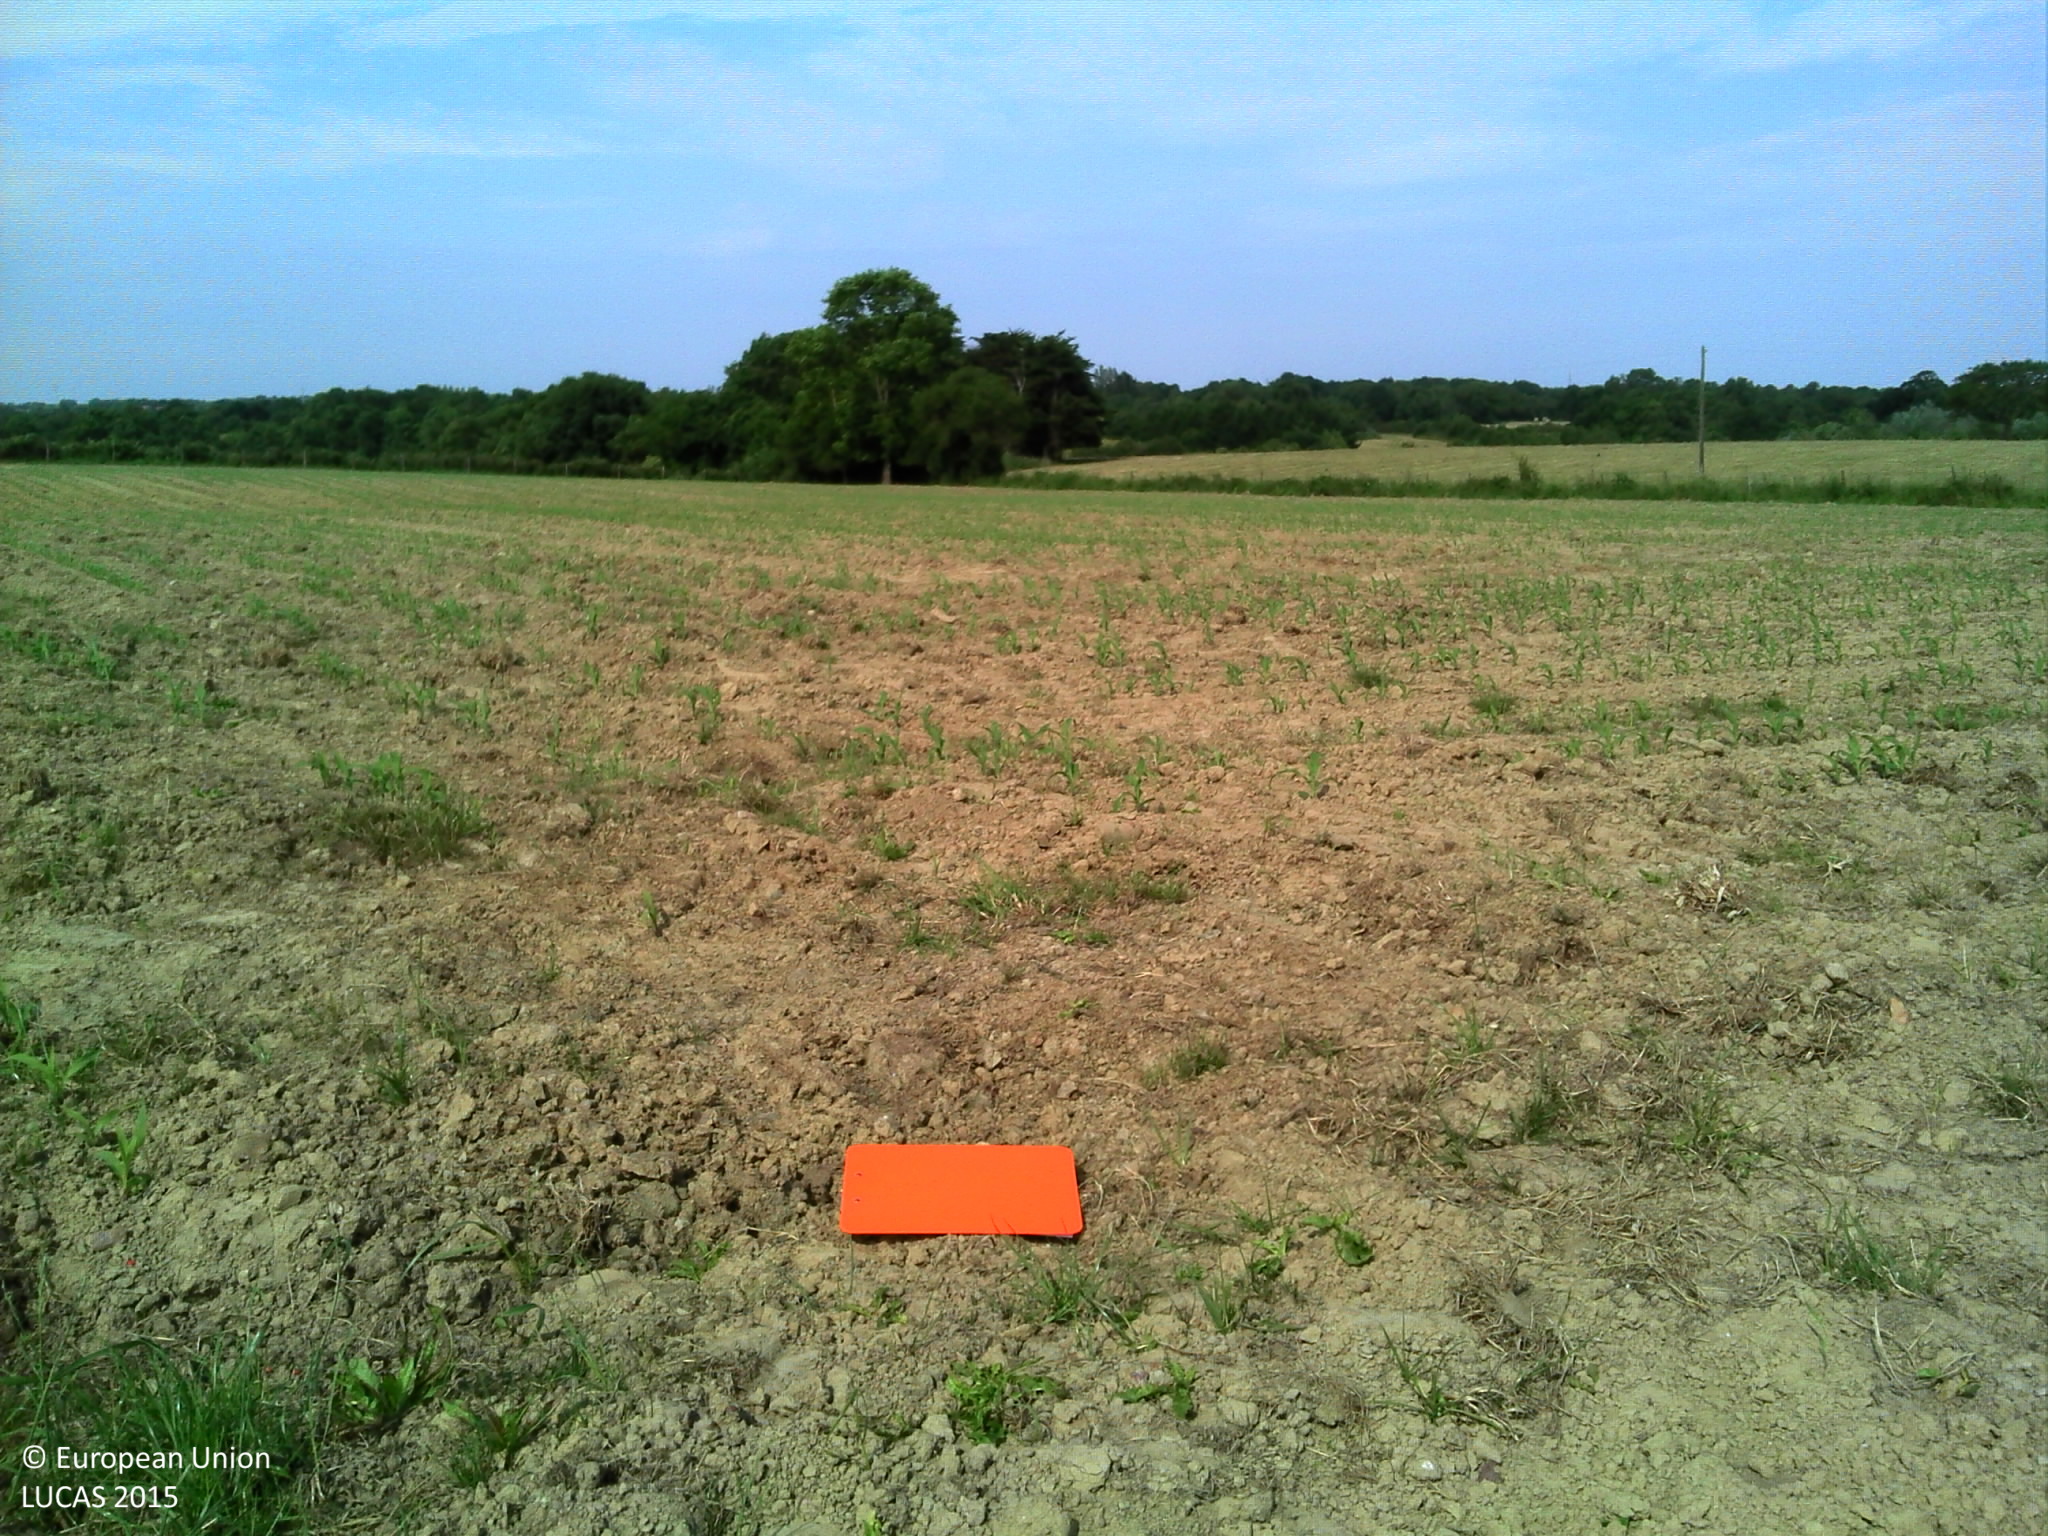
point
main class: Cropland
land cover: Maize
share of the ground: 10 - 25 %
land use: Agriculture (excluding fallow land and kitchen gardens)
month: June
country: FR
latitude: 47.1579
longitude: -2.0648
